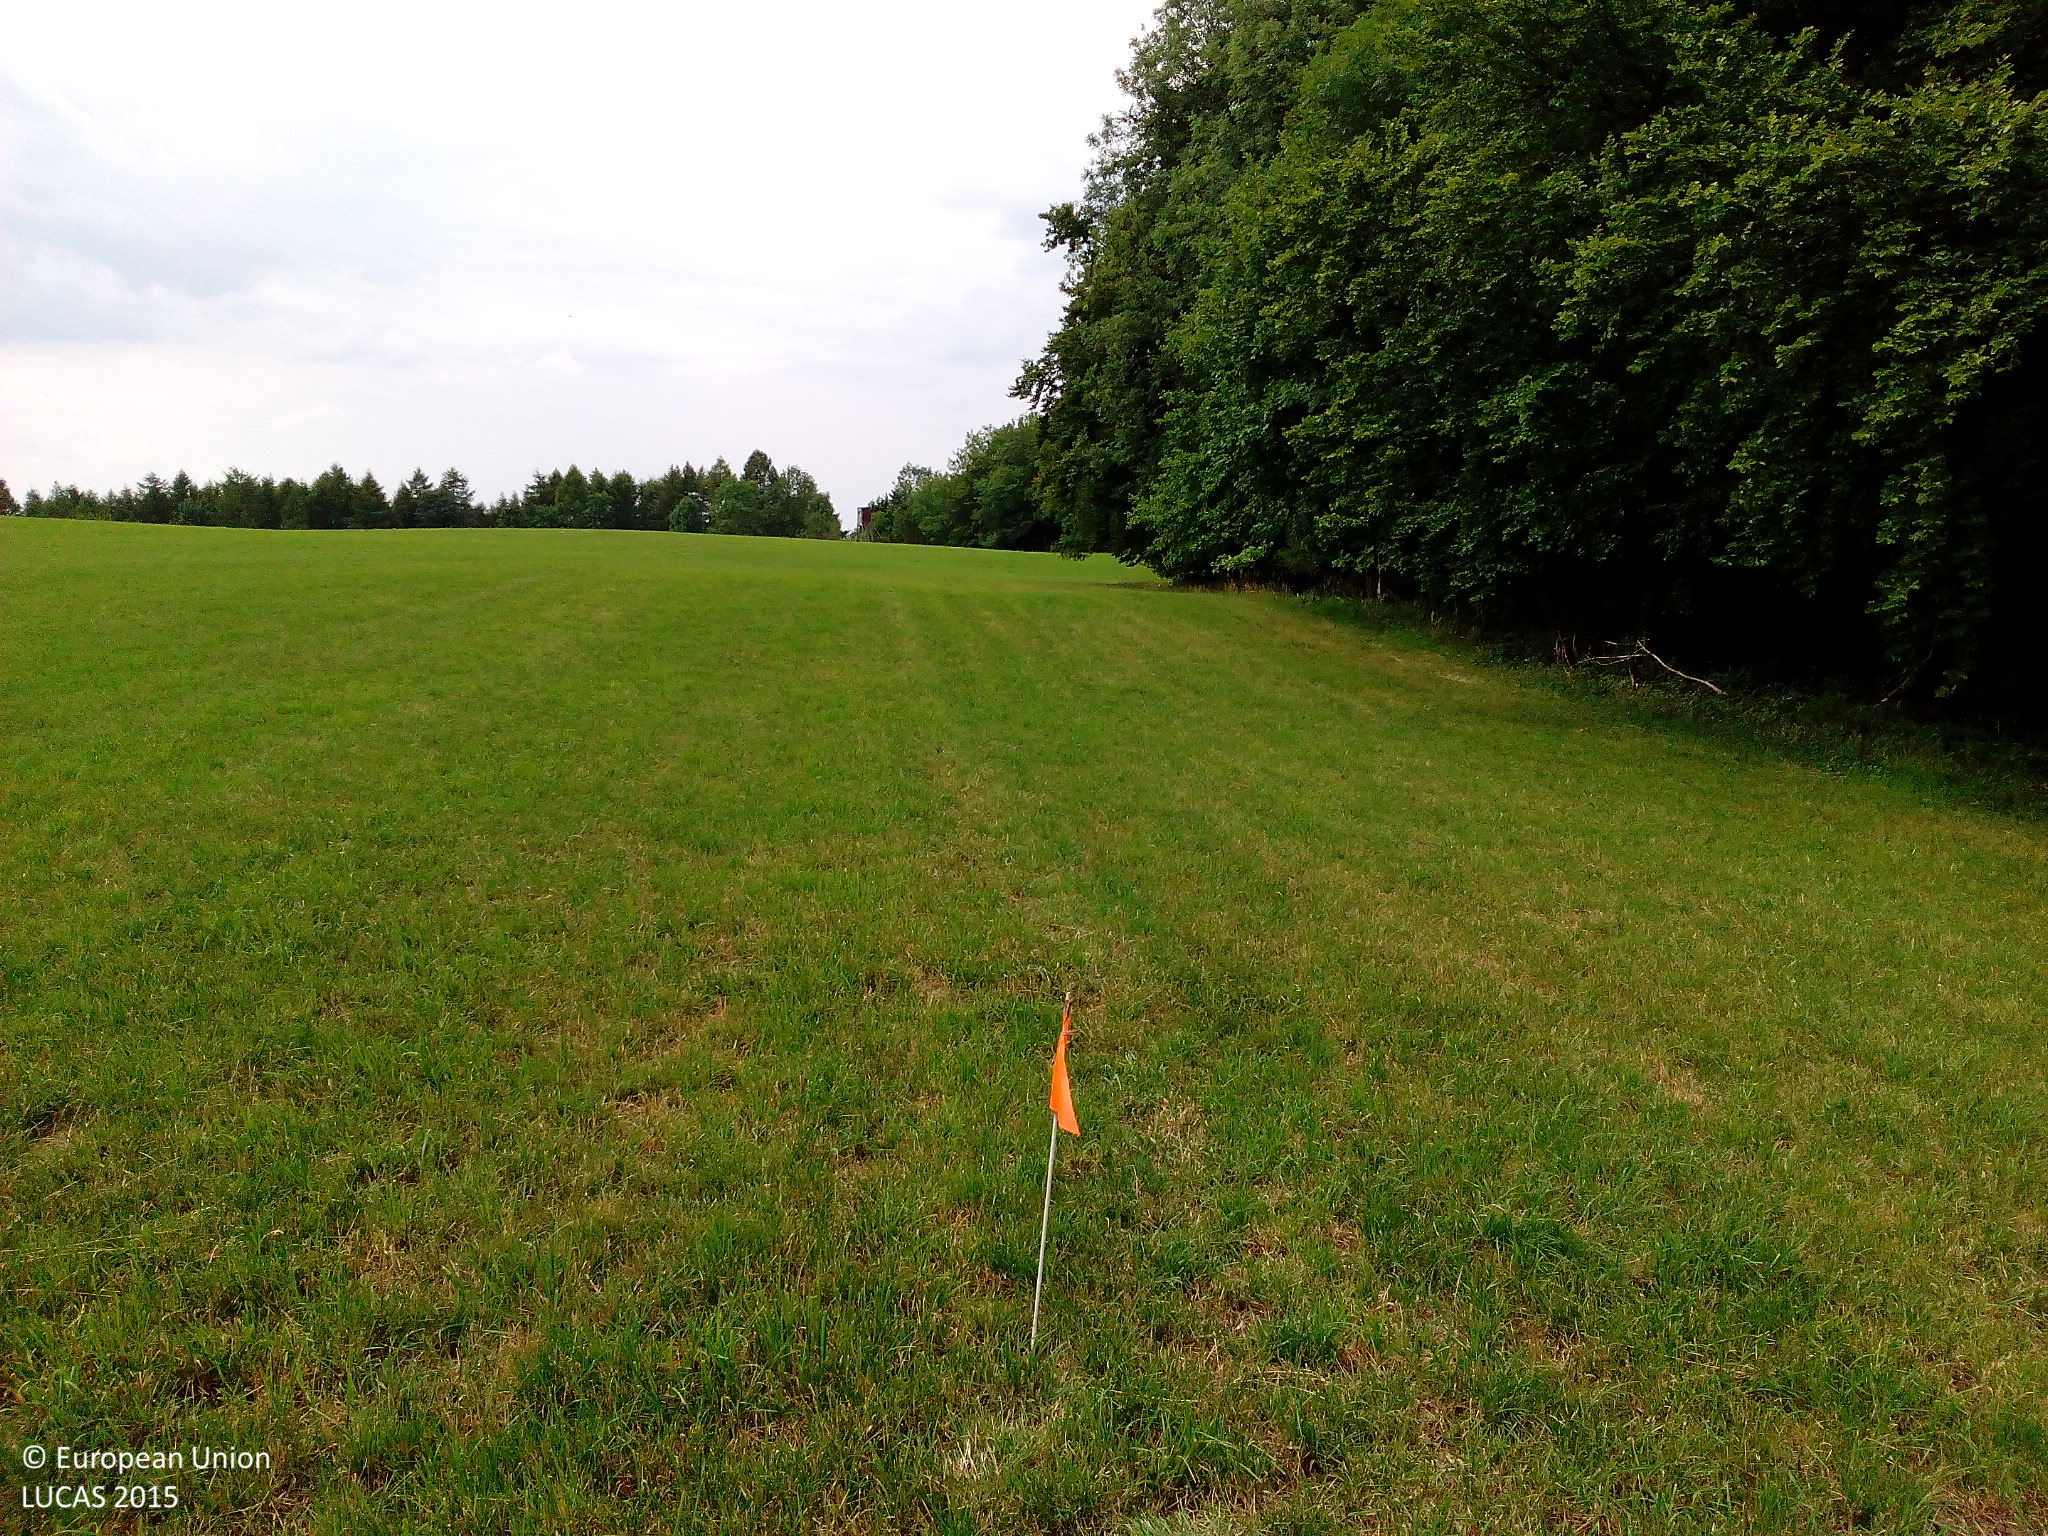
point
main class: Grassland
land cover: Grassland without tree/shrub cover
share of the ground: > 75 %
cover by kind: herbaceous plants 100 %
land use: Agriculture (excluding fallow land and kitchen gardens)
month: July
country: DE
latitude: 50.8135
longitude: 9.9007
